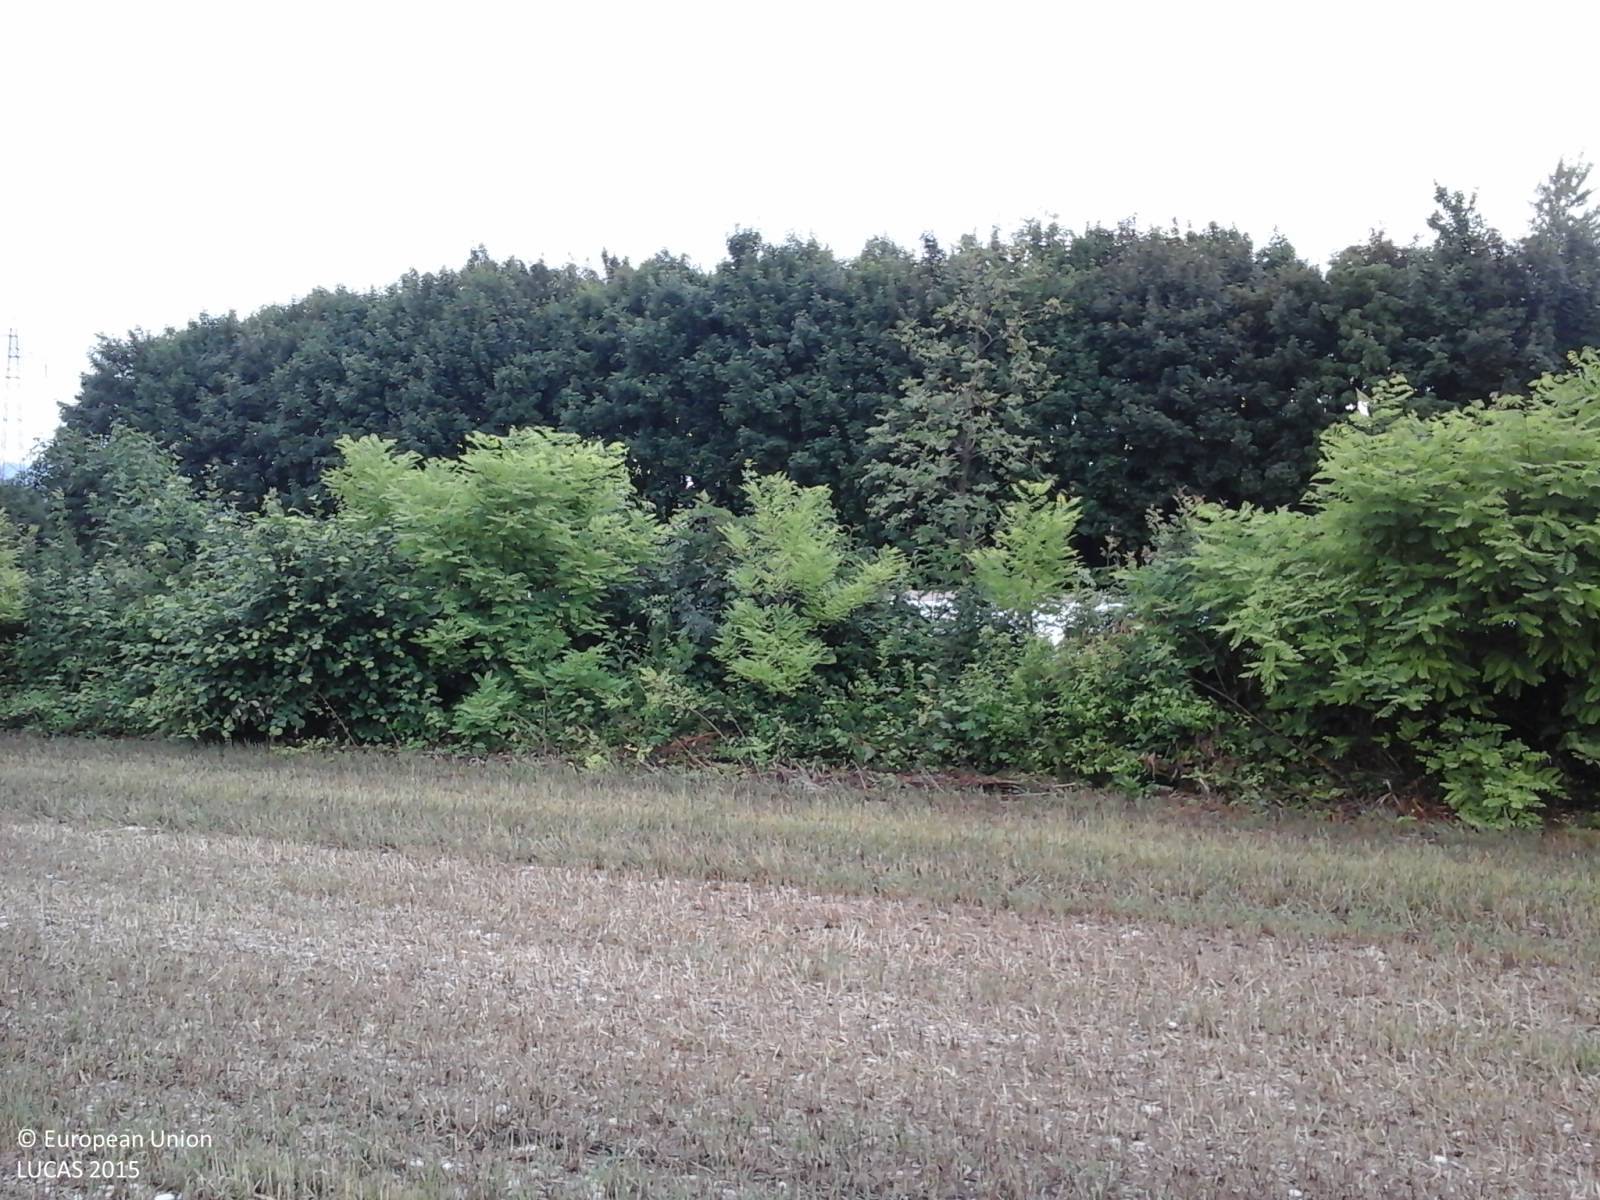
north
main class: Cropland
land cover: Common wheat
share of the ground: < 10 %
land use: Agriculture (excluding fallow land and kitchen gardens)
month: June
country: IT
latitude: 46.1169
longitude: 12.7788
